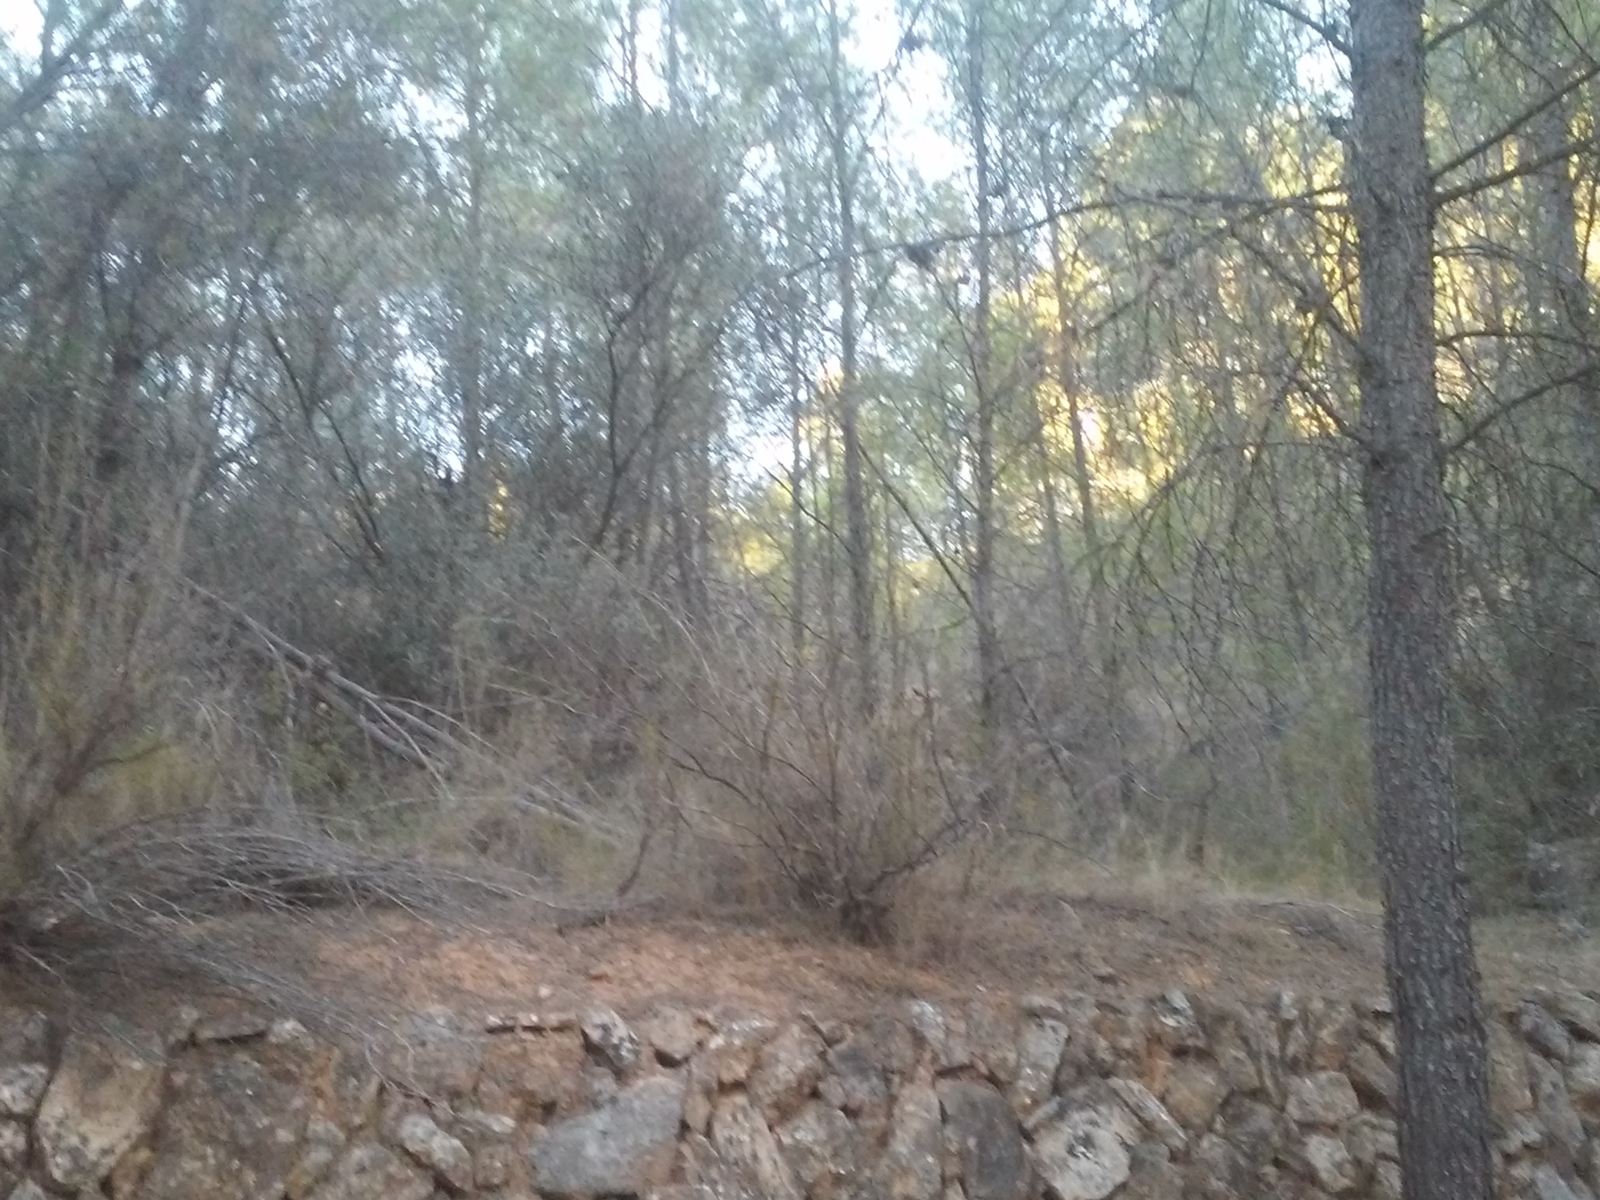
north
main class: Woodland
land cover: Pine dominated coniferous woodland
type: coniferous forest of the mediterranean region
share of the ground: 50 - 75 %
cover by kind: coniferous forest trees 50 %, shrubs 35 %, herbaceous plants 10 %, broadleaved forest trees 5 %
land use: Semi-natural and natural areas not in use
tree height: < 5 m
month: September
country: ES
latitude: 41.1672
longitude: 0.6591
